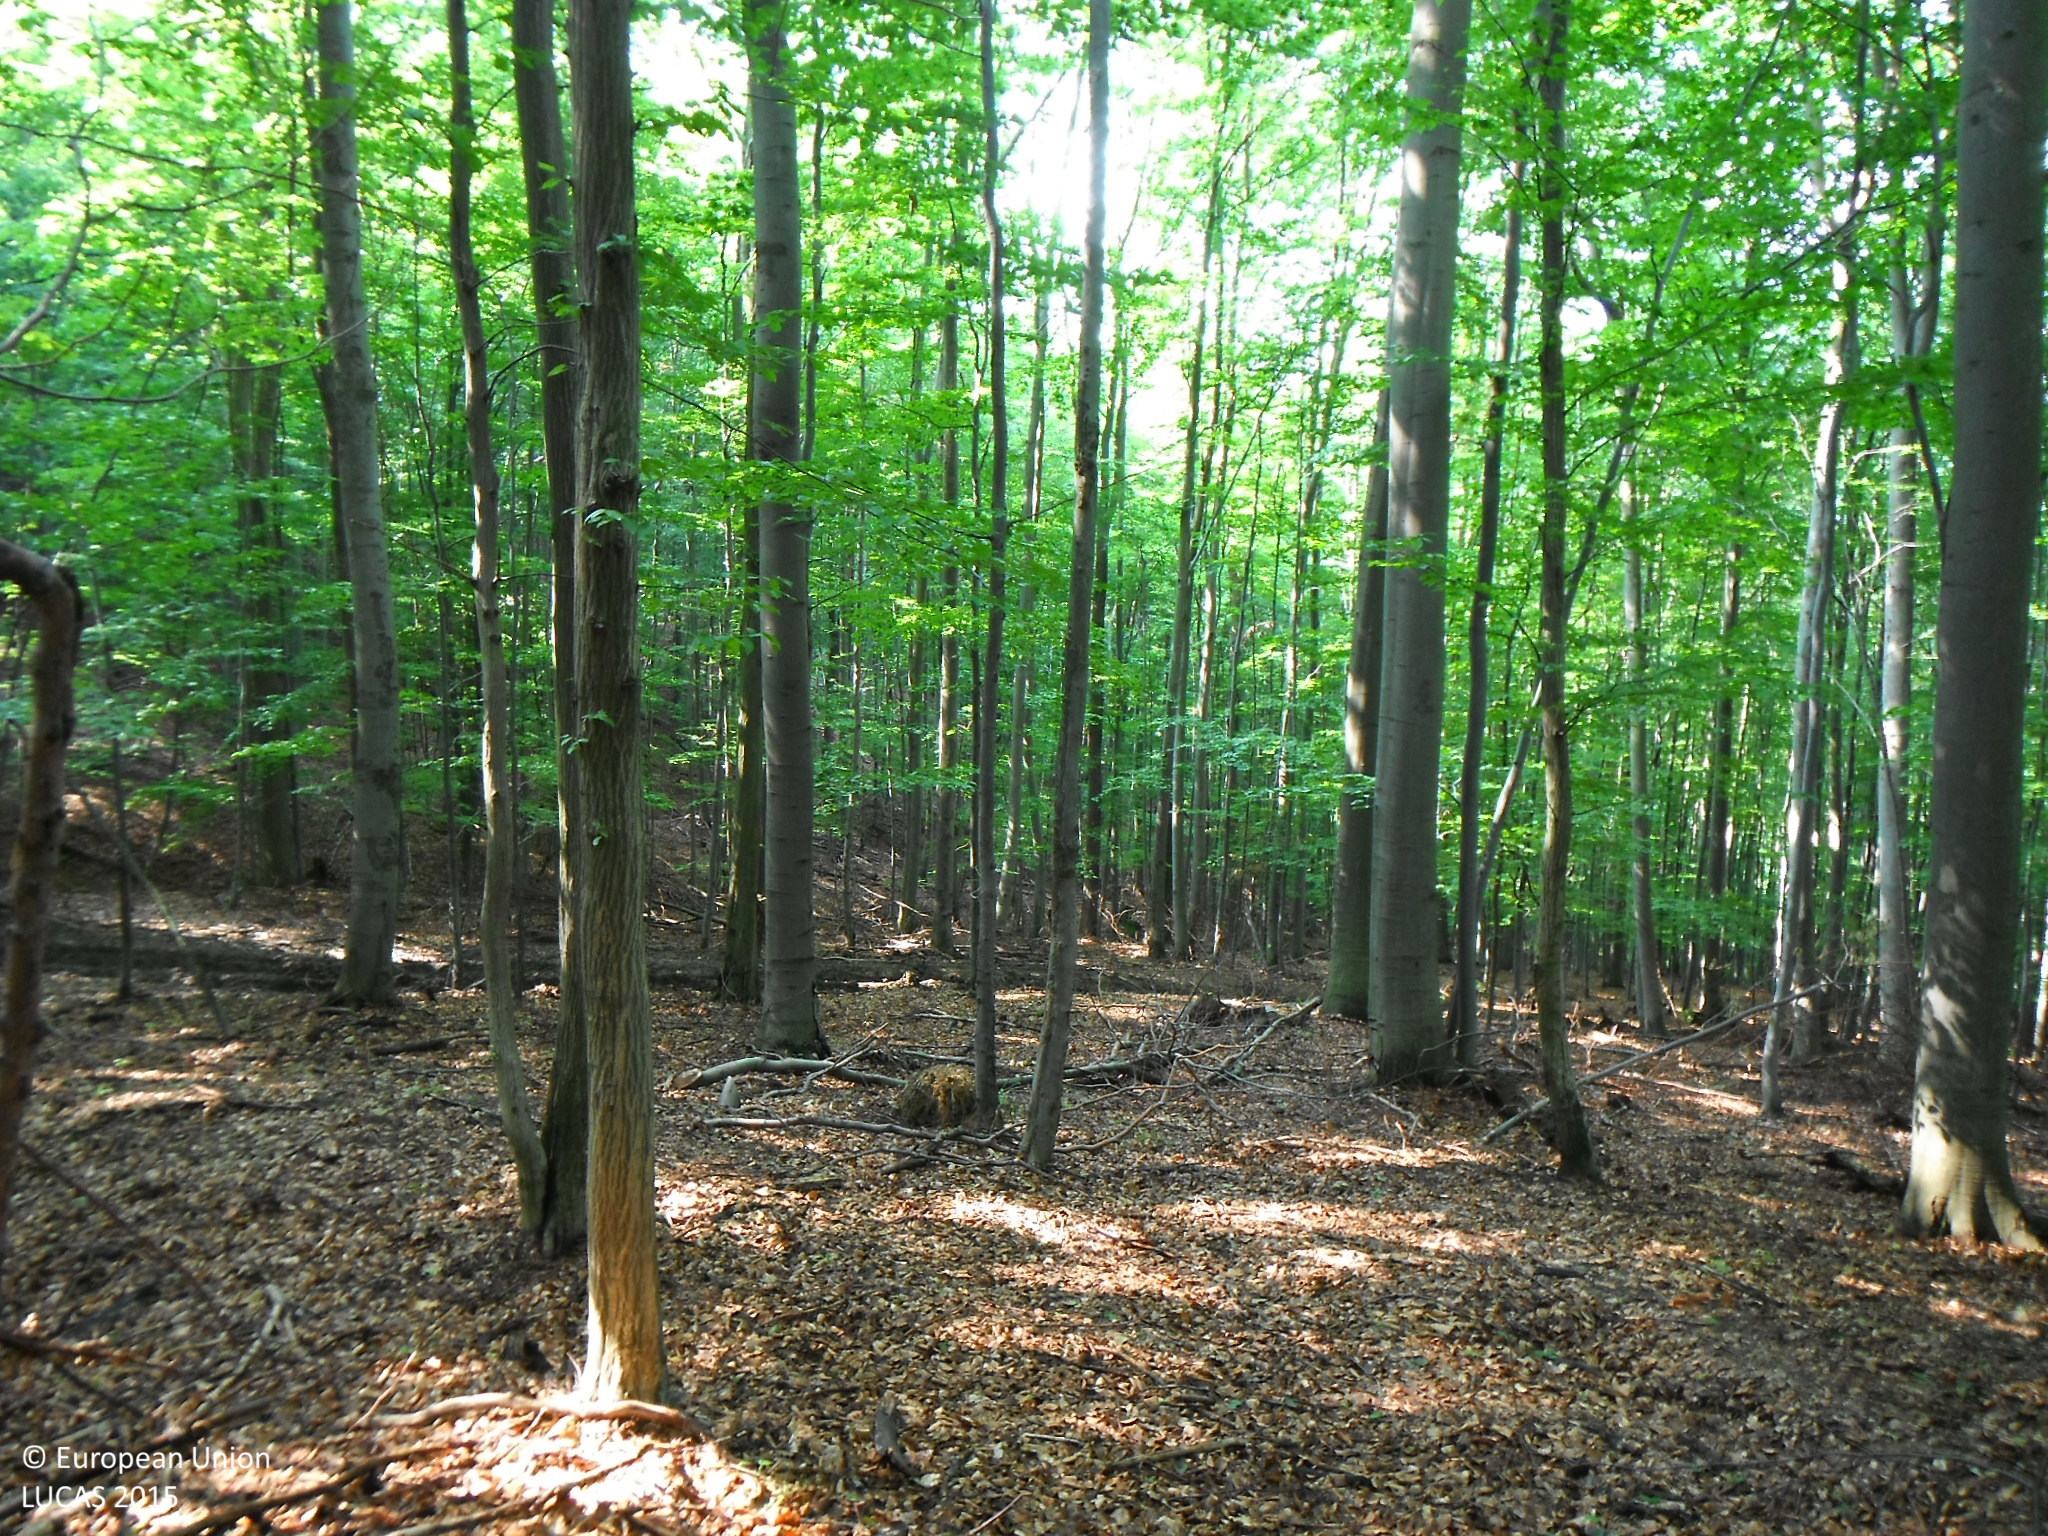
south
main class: Woodland
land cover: Broadleaved woodland
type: beech forest
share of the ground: > 75 %
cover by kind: broadleaved forest trees 95 %, herbaceous plants 5 %
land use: Forestry
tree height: > 5 m
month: July
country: SK
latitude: 49.3870
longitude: 21.2738
